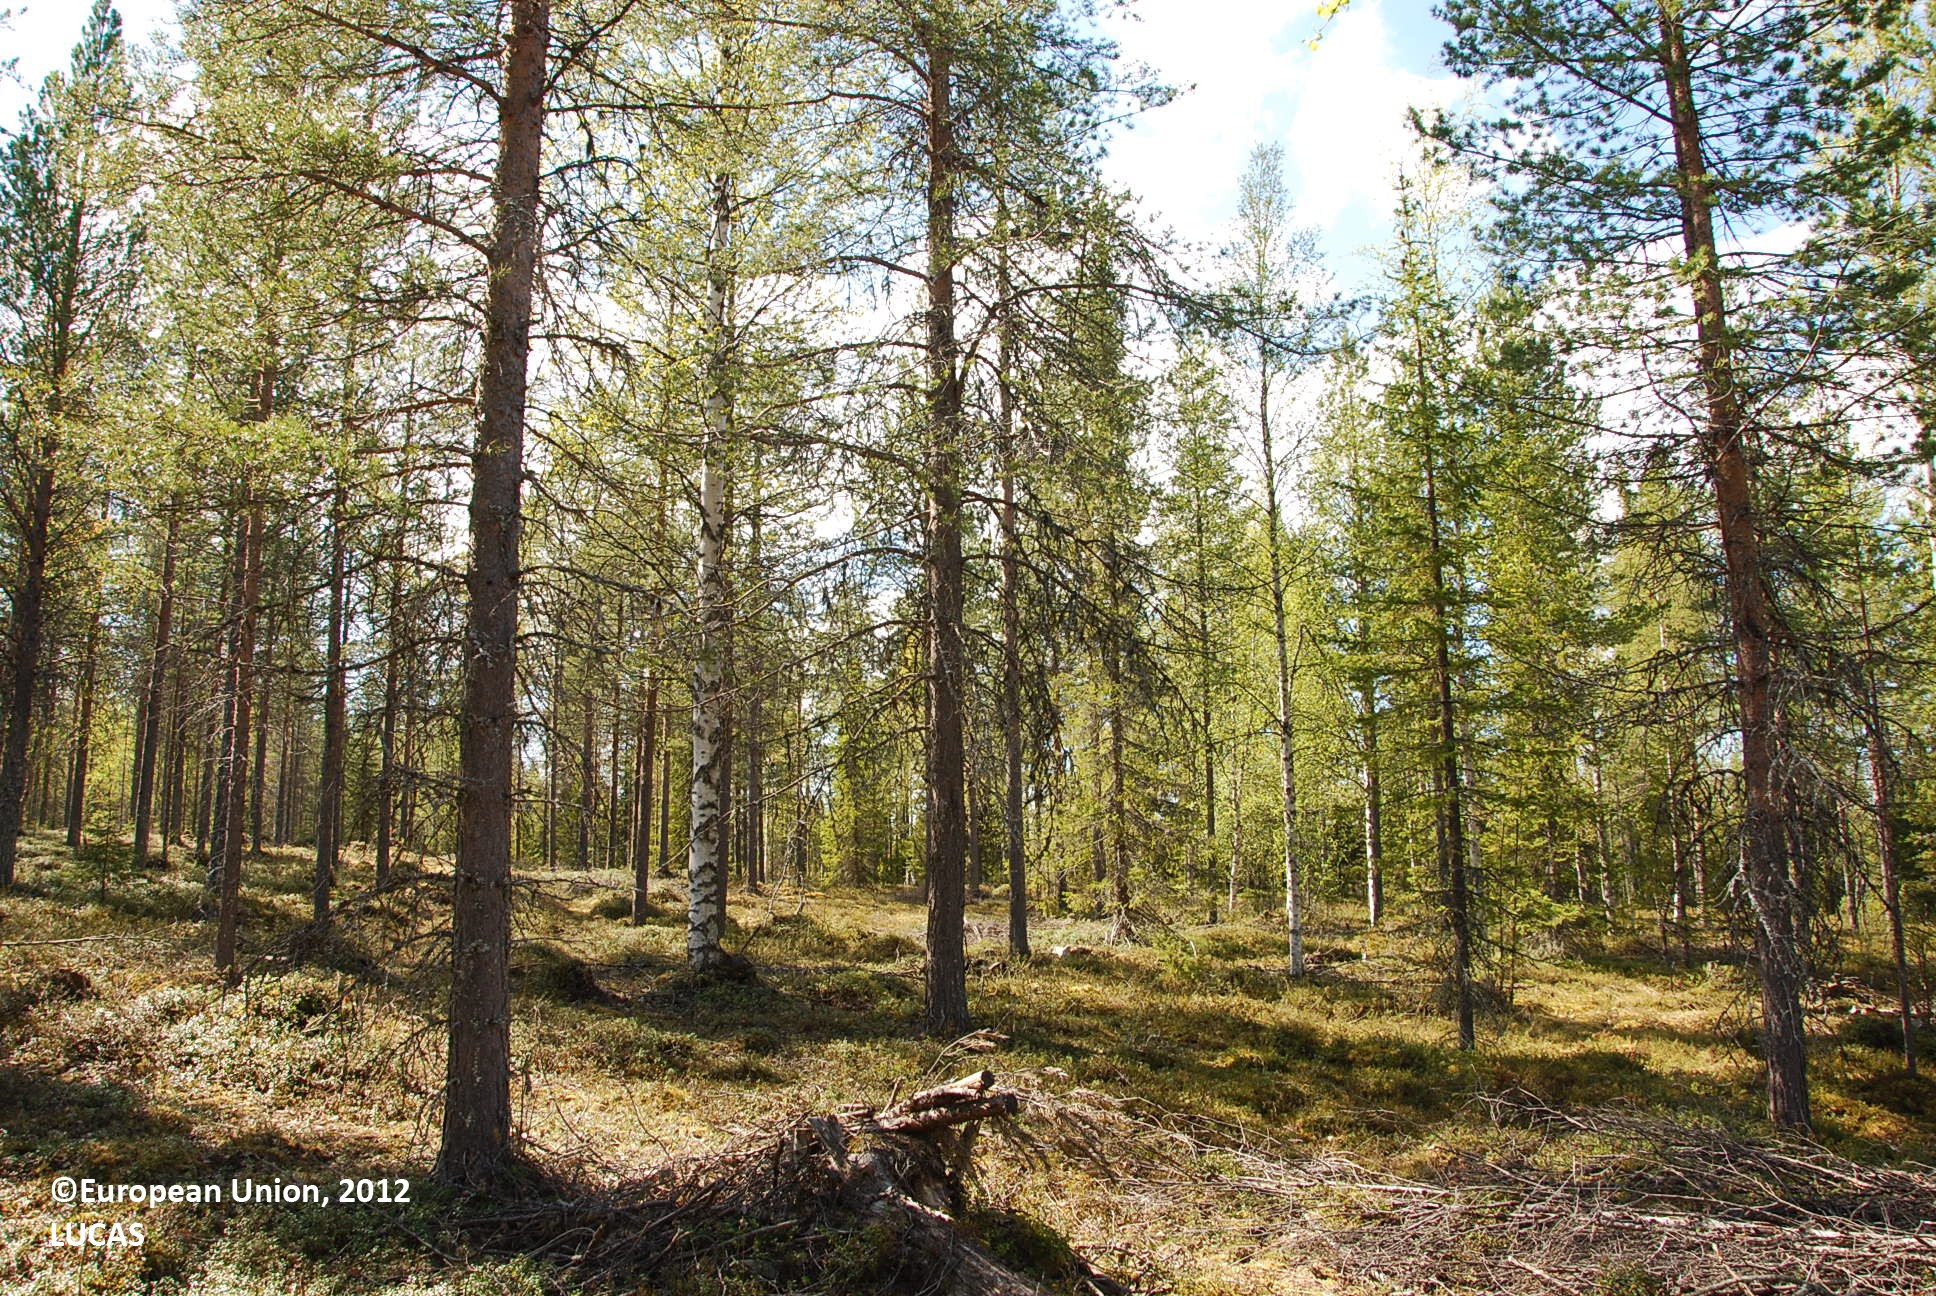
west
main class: Woodland
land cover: Spruce dominated mixed woodland
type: boreal forest
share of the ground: 50 - 75 %
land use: Forestry
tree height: > 5 m
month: June
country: FI
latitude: 66.9655
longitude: 28.2925
